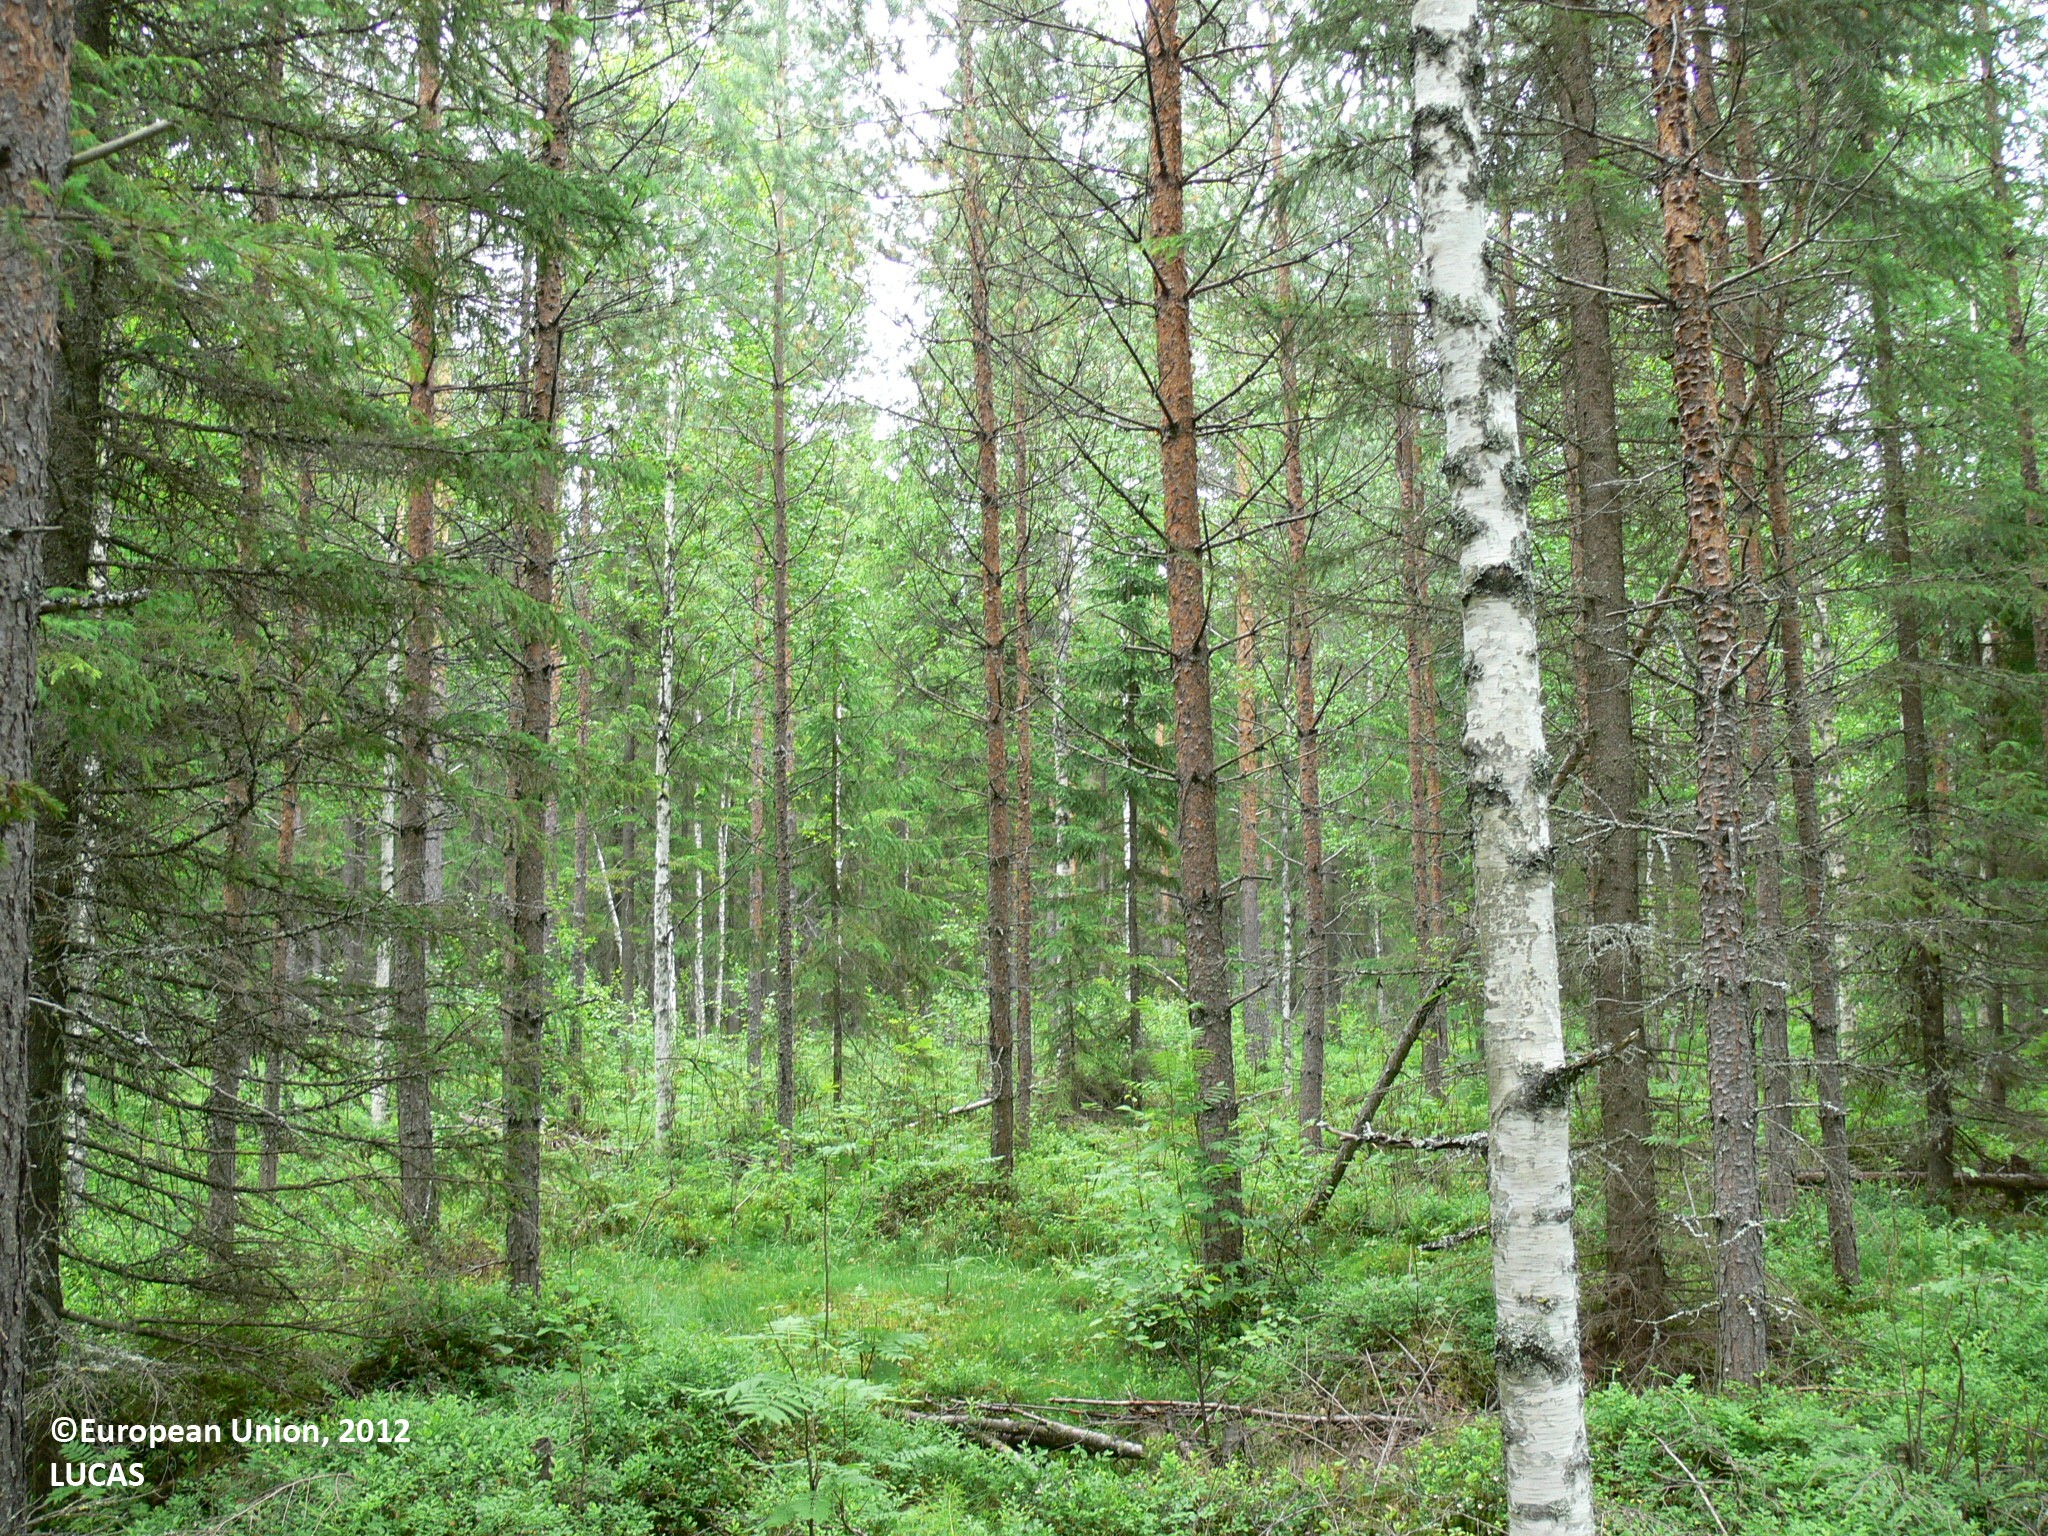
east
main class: Woodland
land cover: Other mixed woodland
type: boreal forest
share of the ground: > 75 %
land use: Forestry
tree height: > 5 m
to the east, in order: Other mixed woodland; Spruce dominated coniferous woodland; Other mixed woodland; Spruce dominated coniferous woodland; Other mixed woodland
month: June
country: FI
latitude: 62.8462
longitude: 29.3800
